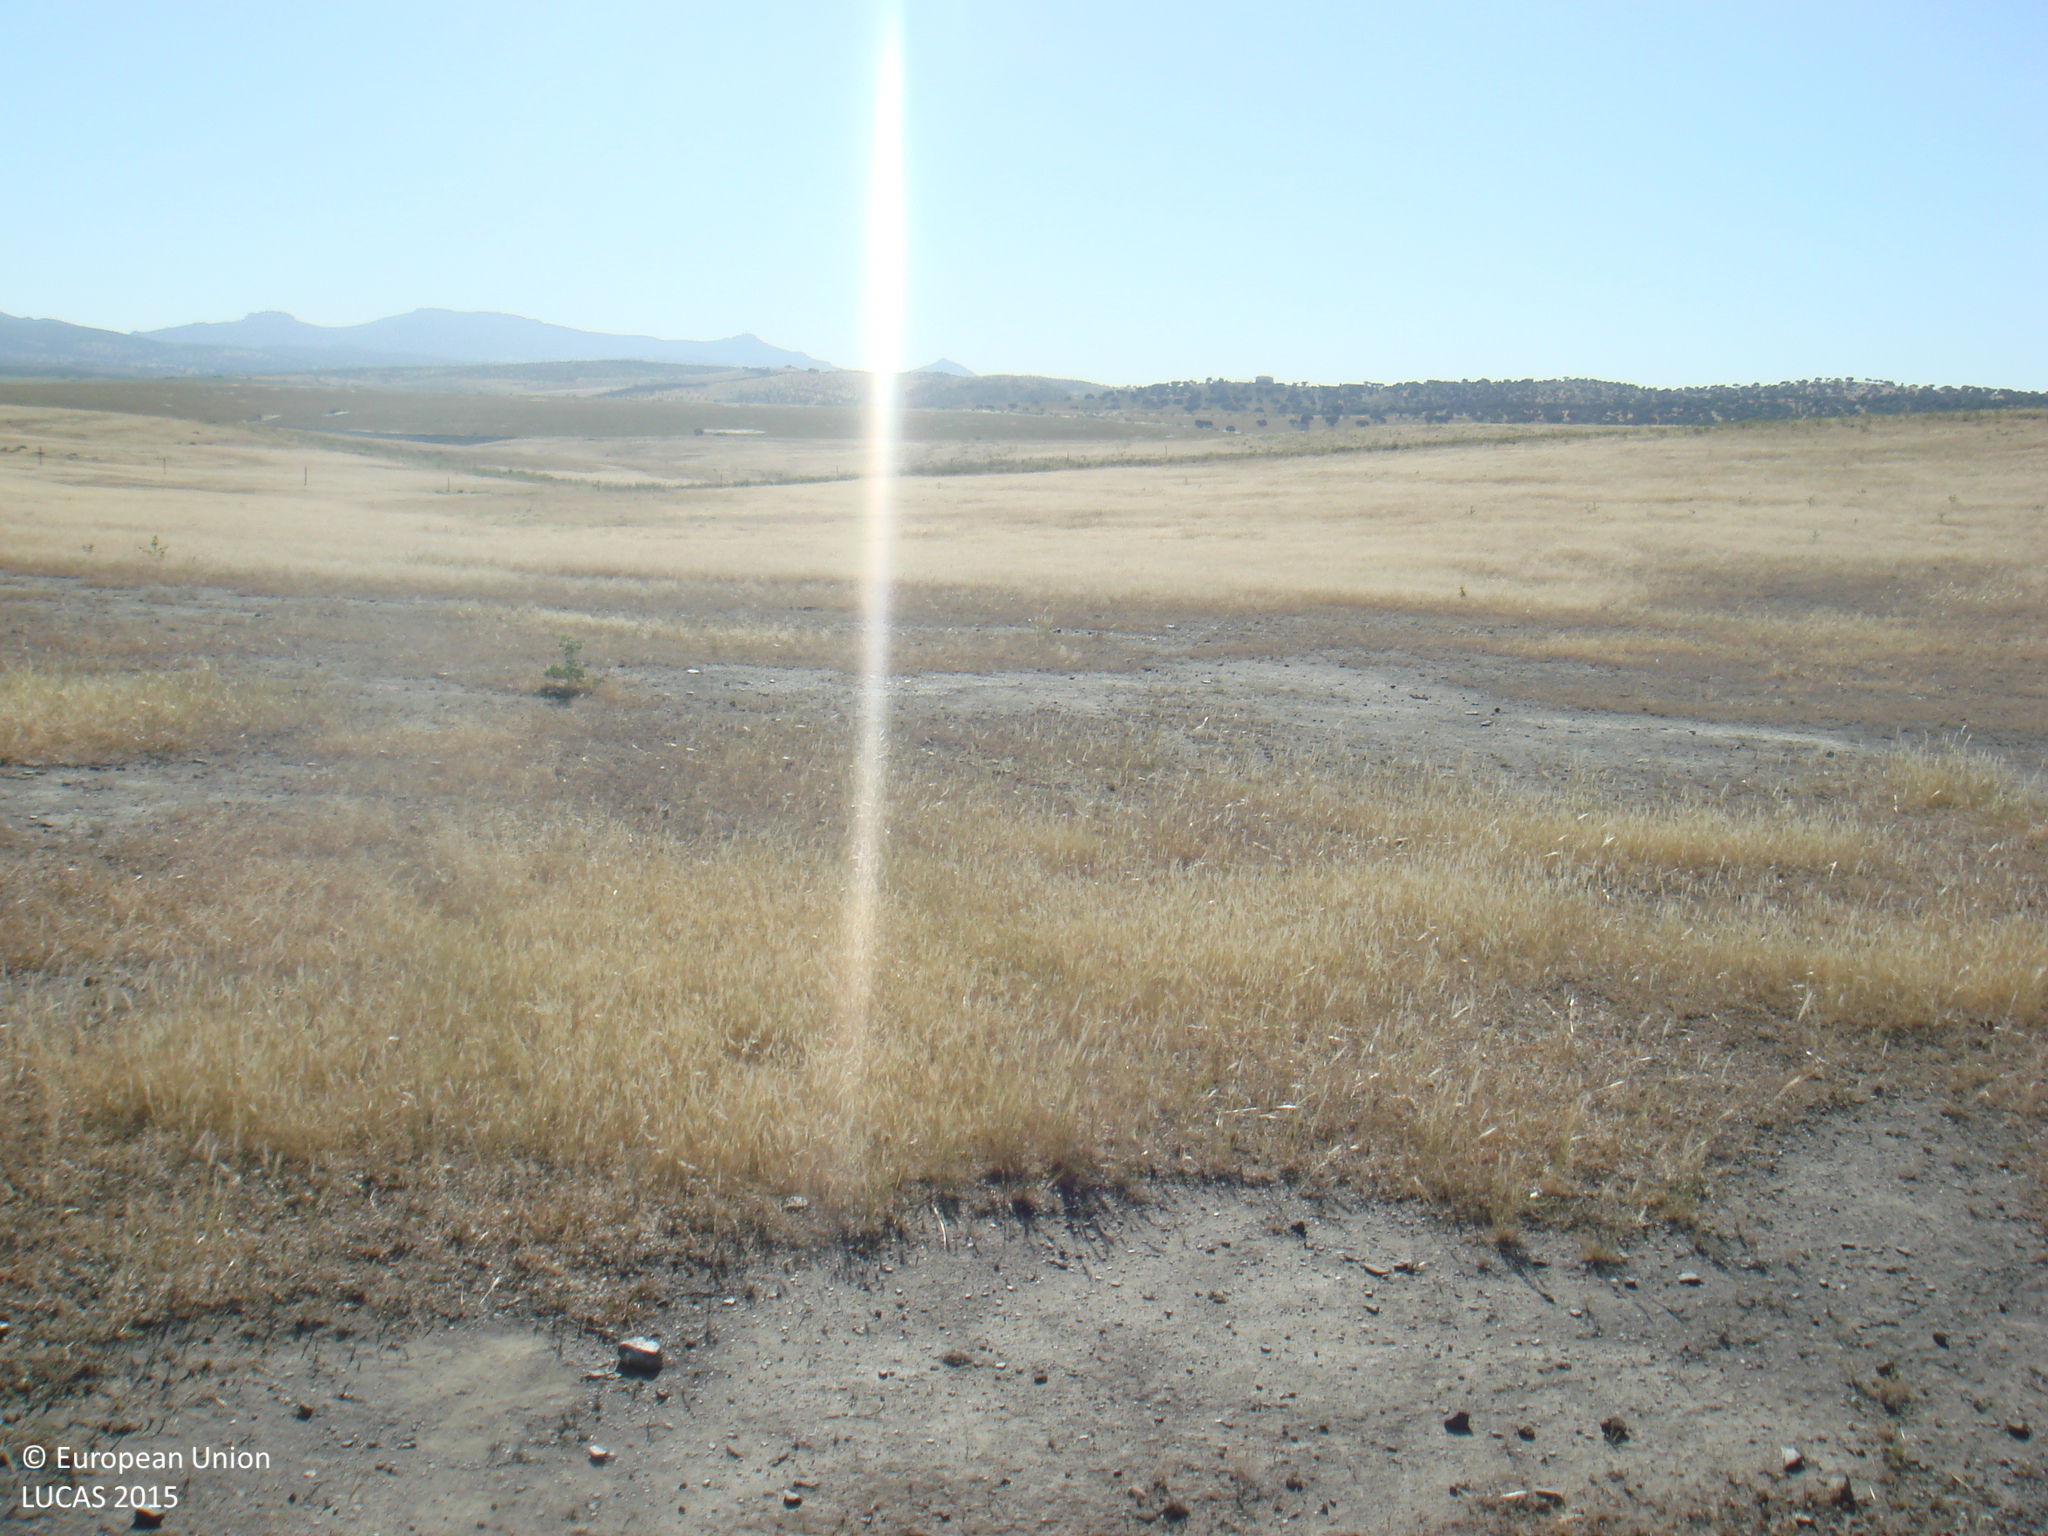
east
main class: Grassland
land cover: Spontaneously vegetated surfaces
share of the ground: > 75 %
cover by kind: herbaceous plants 100 %
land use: Agriculture (excluding fallow land and kitchen gardens)
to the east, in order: Spontaneously vegetated surfaces; Fences; Spontaneously vegetated surfaces
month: May
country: ES
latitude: 38.5975
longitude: -5.0832
